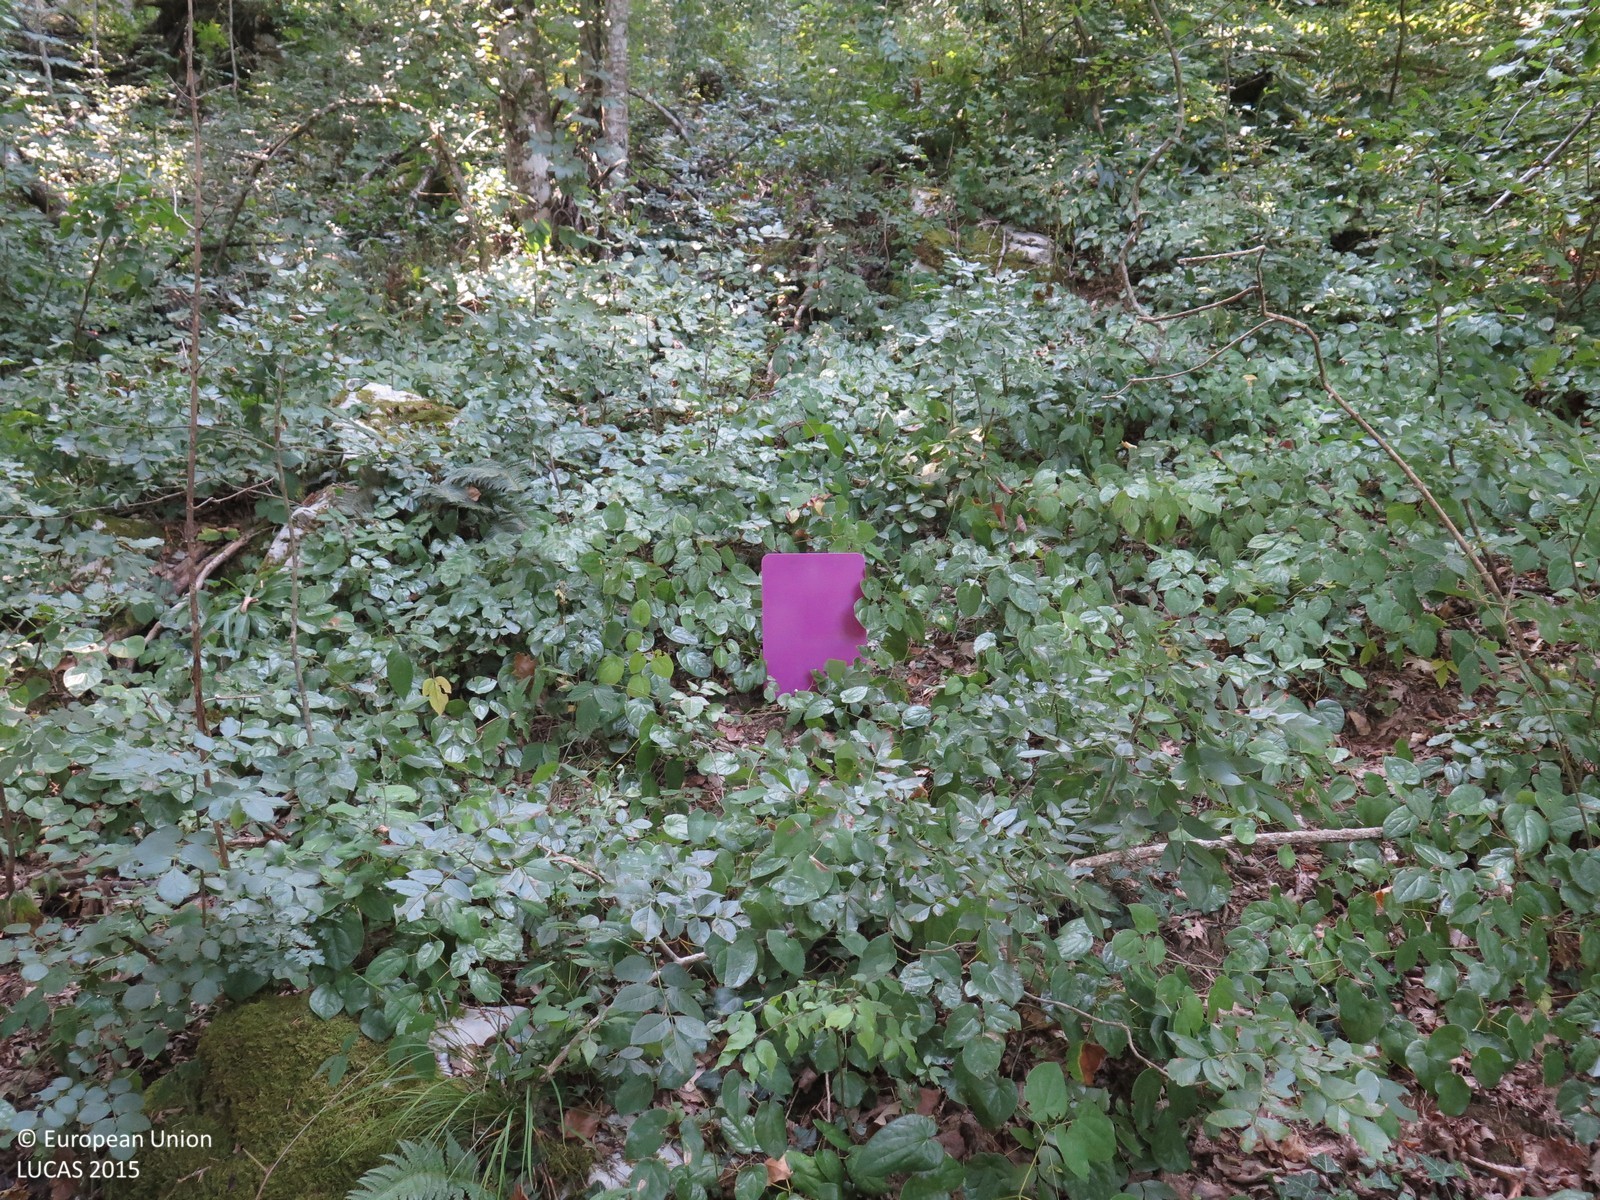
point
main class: Woodland
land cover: Broadleaved woodland
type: beech forest
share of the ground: > 75 %
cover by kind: broadleaved forest trees 95 %, herbaceous plants 5 %
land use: Semi-natural and natural areas not in use
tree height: > 5 m
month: August
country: HR
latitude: 45.4306
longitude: 15.1979
